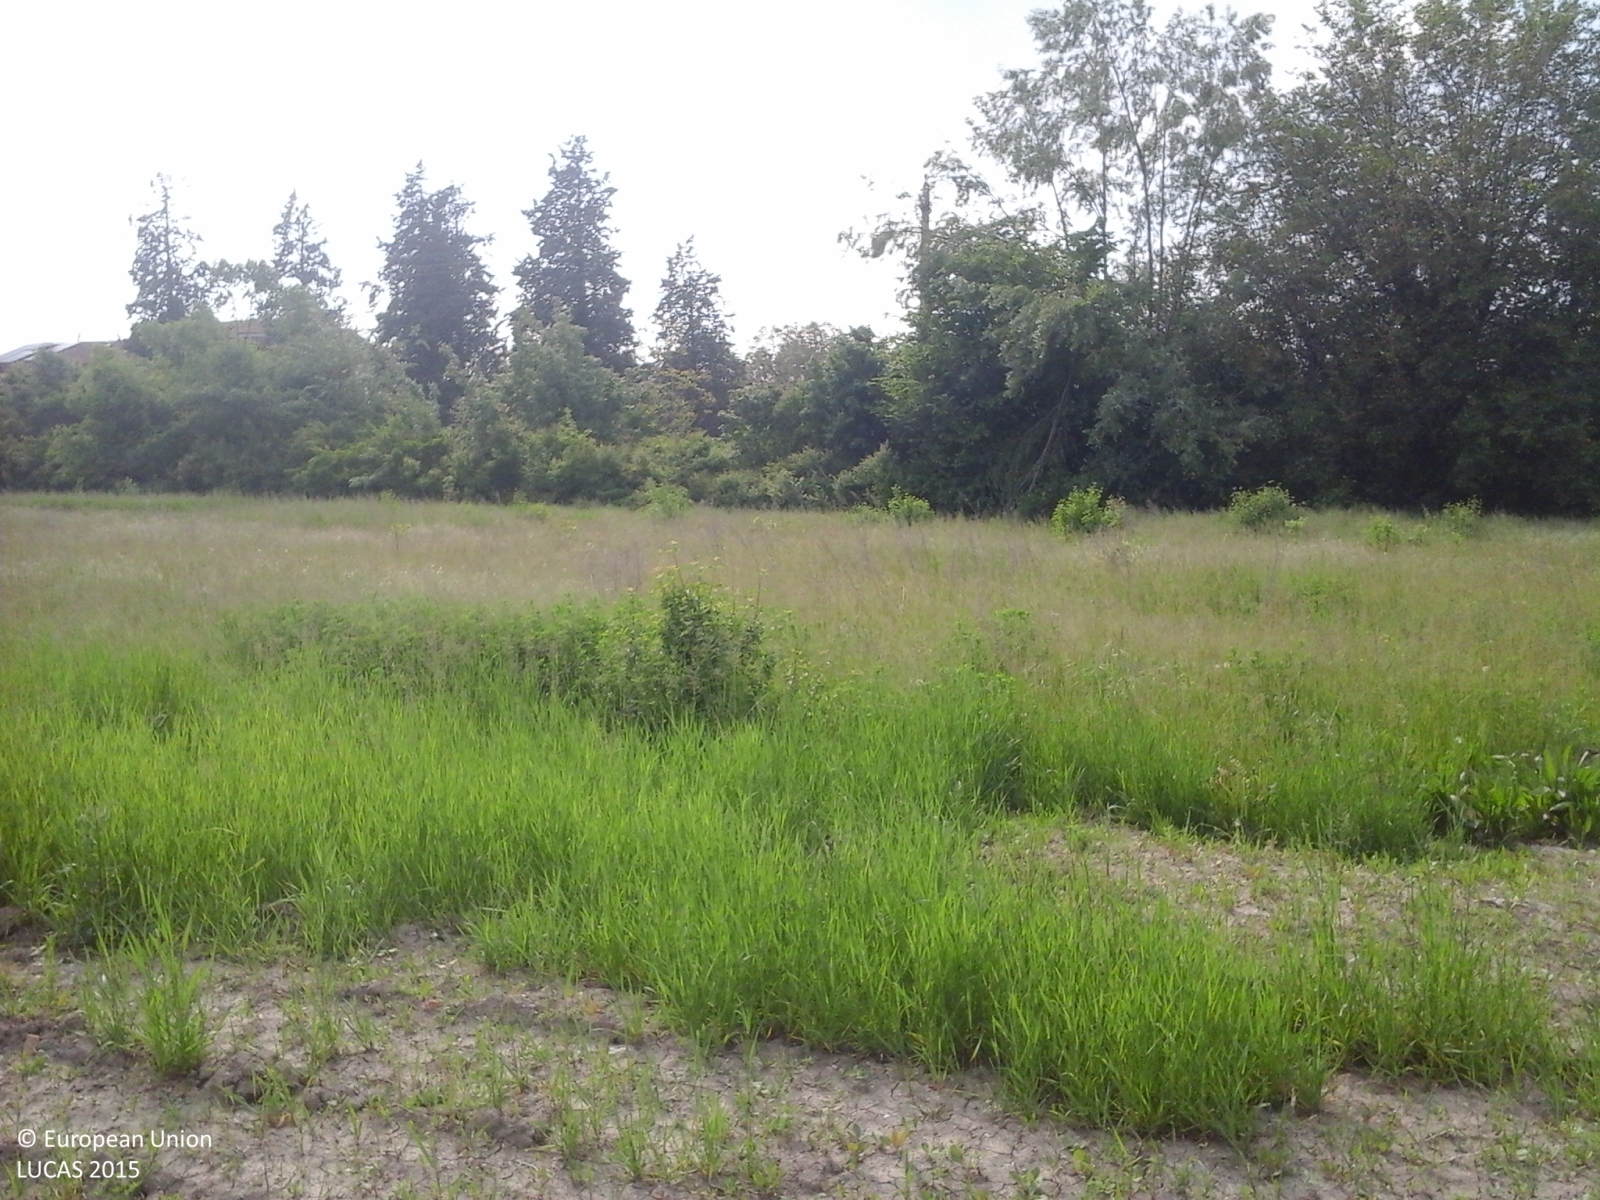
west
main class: Grassland
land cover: Spontaneously vegetated surfaces
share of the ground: 50 - 75 %
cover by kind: herbaceous plants 100 %
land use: Agriculture (excluding fallow land and kitchen gardens)
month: April
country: IT
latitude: 44.7795
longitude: 10.8954
